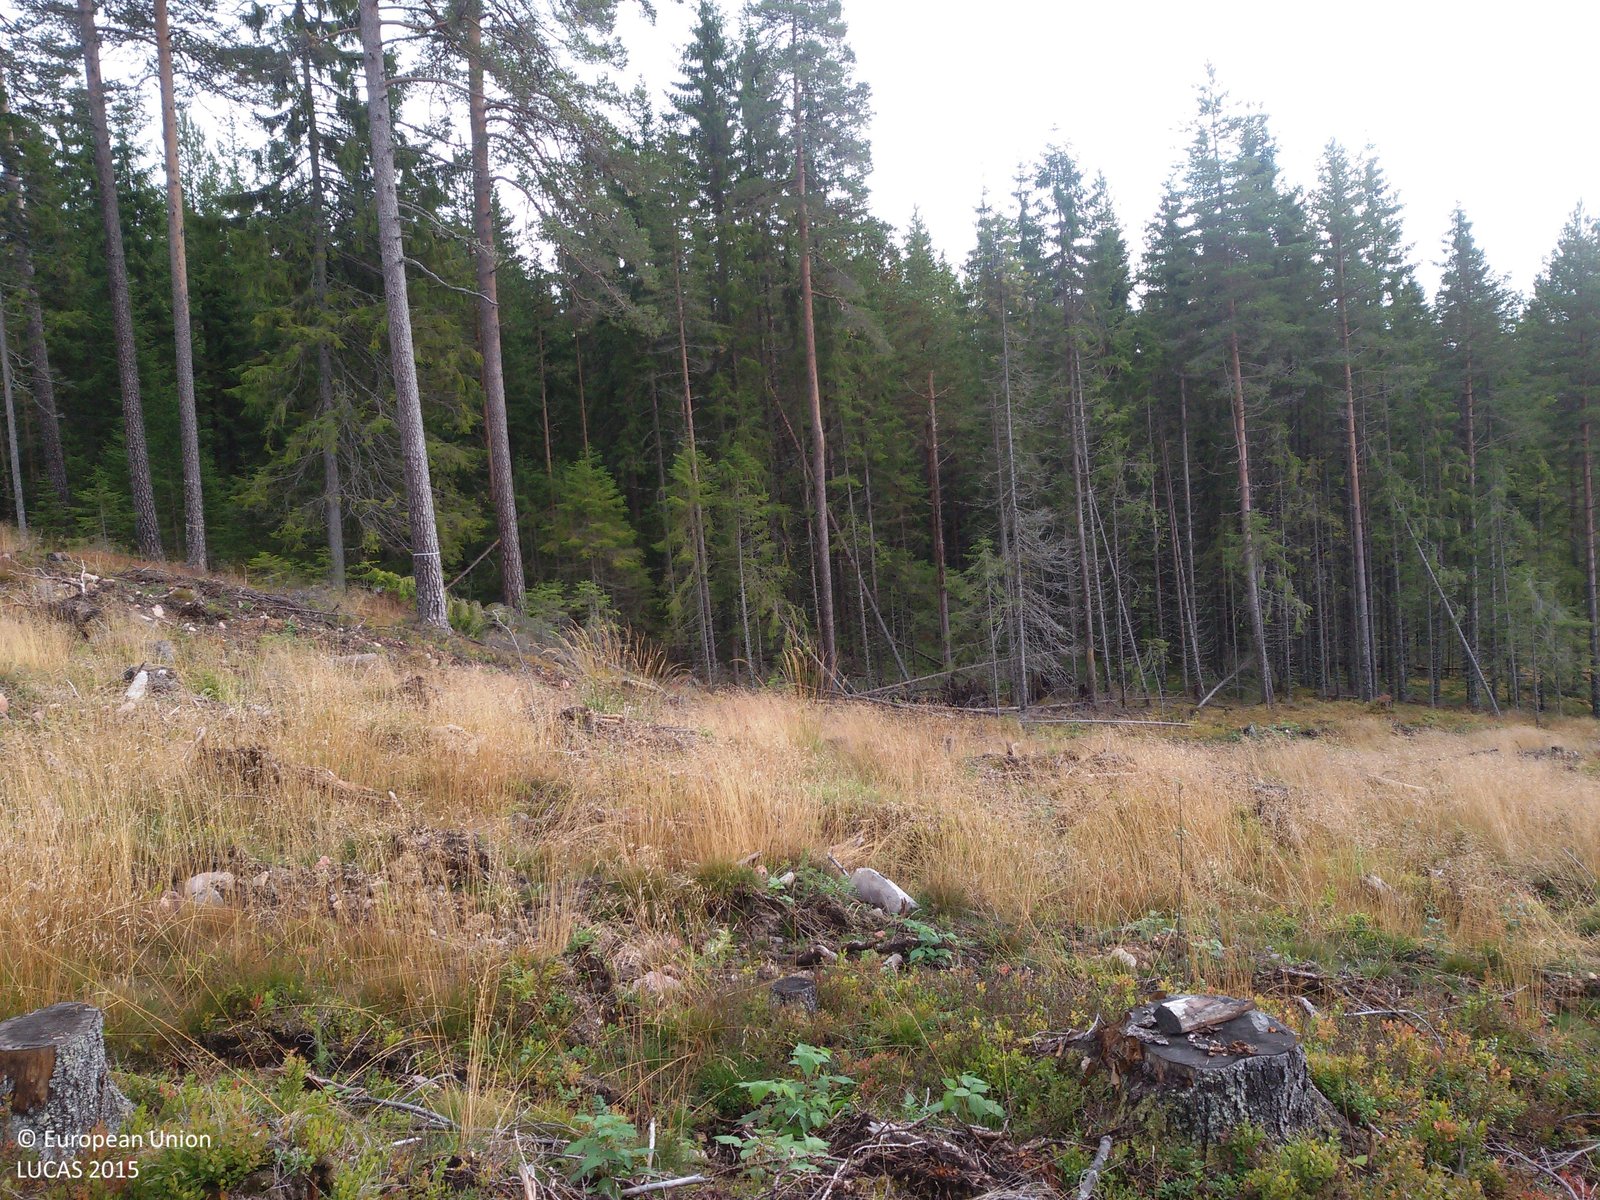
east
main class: Woodland
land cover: Spruce dominated coniferous woodland
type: boreal forest
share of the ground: < 10 %
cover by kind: herbaceous plants 70 %, unconsolidated bare surface 15 %, coniferous forest trees 10 %, lichens and mosses 5 %
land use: Forestry
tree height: < 5 m
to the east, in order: Spruce dominated coniferous woodland
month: September
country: SE
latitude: 60.9440
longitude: 14.3248
